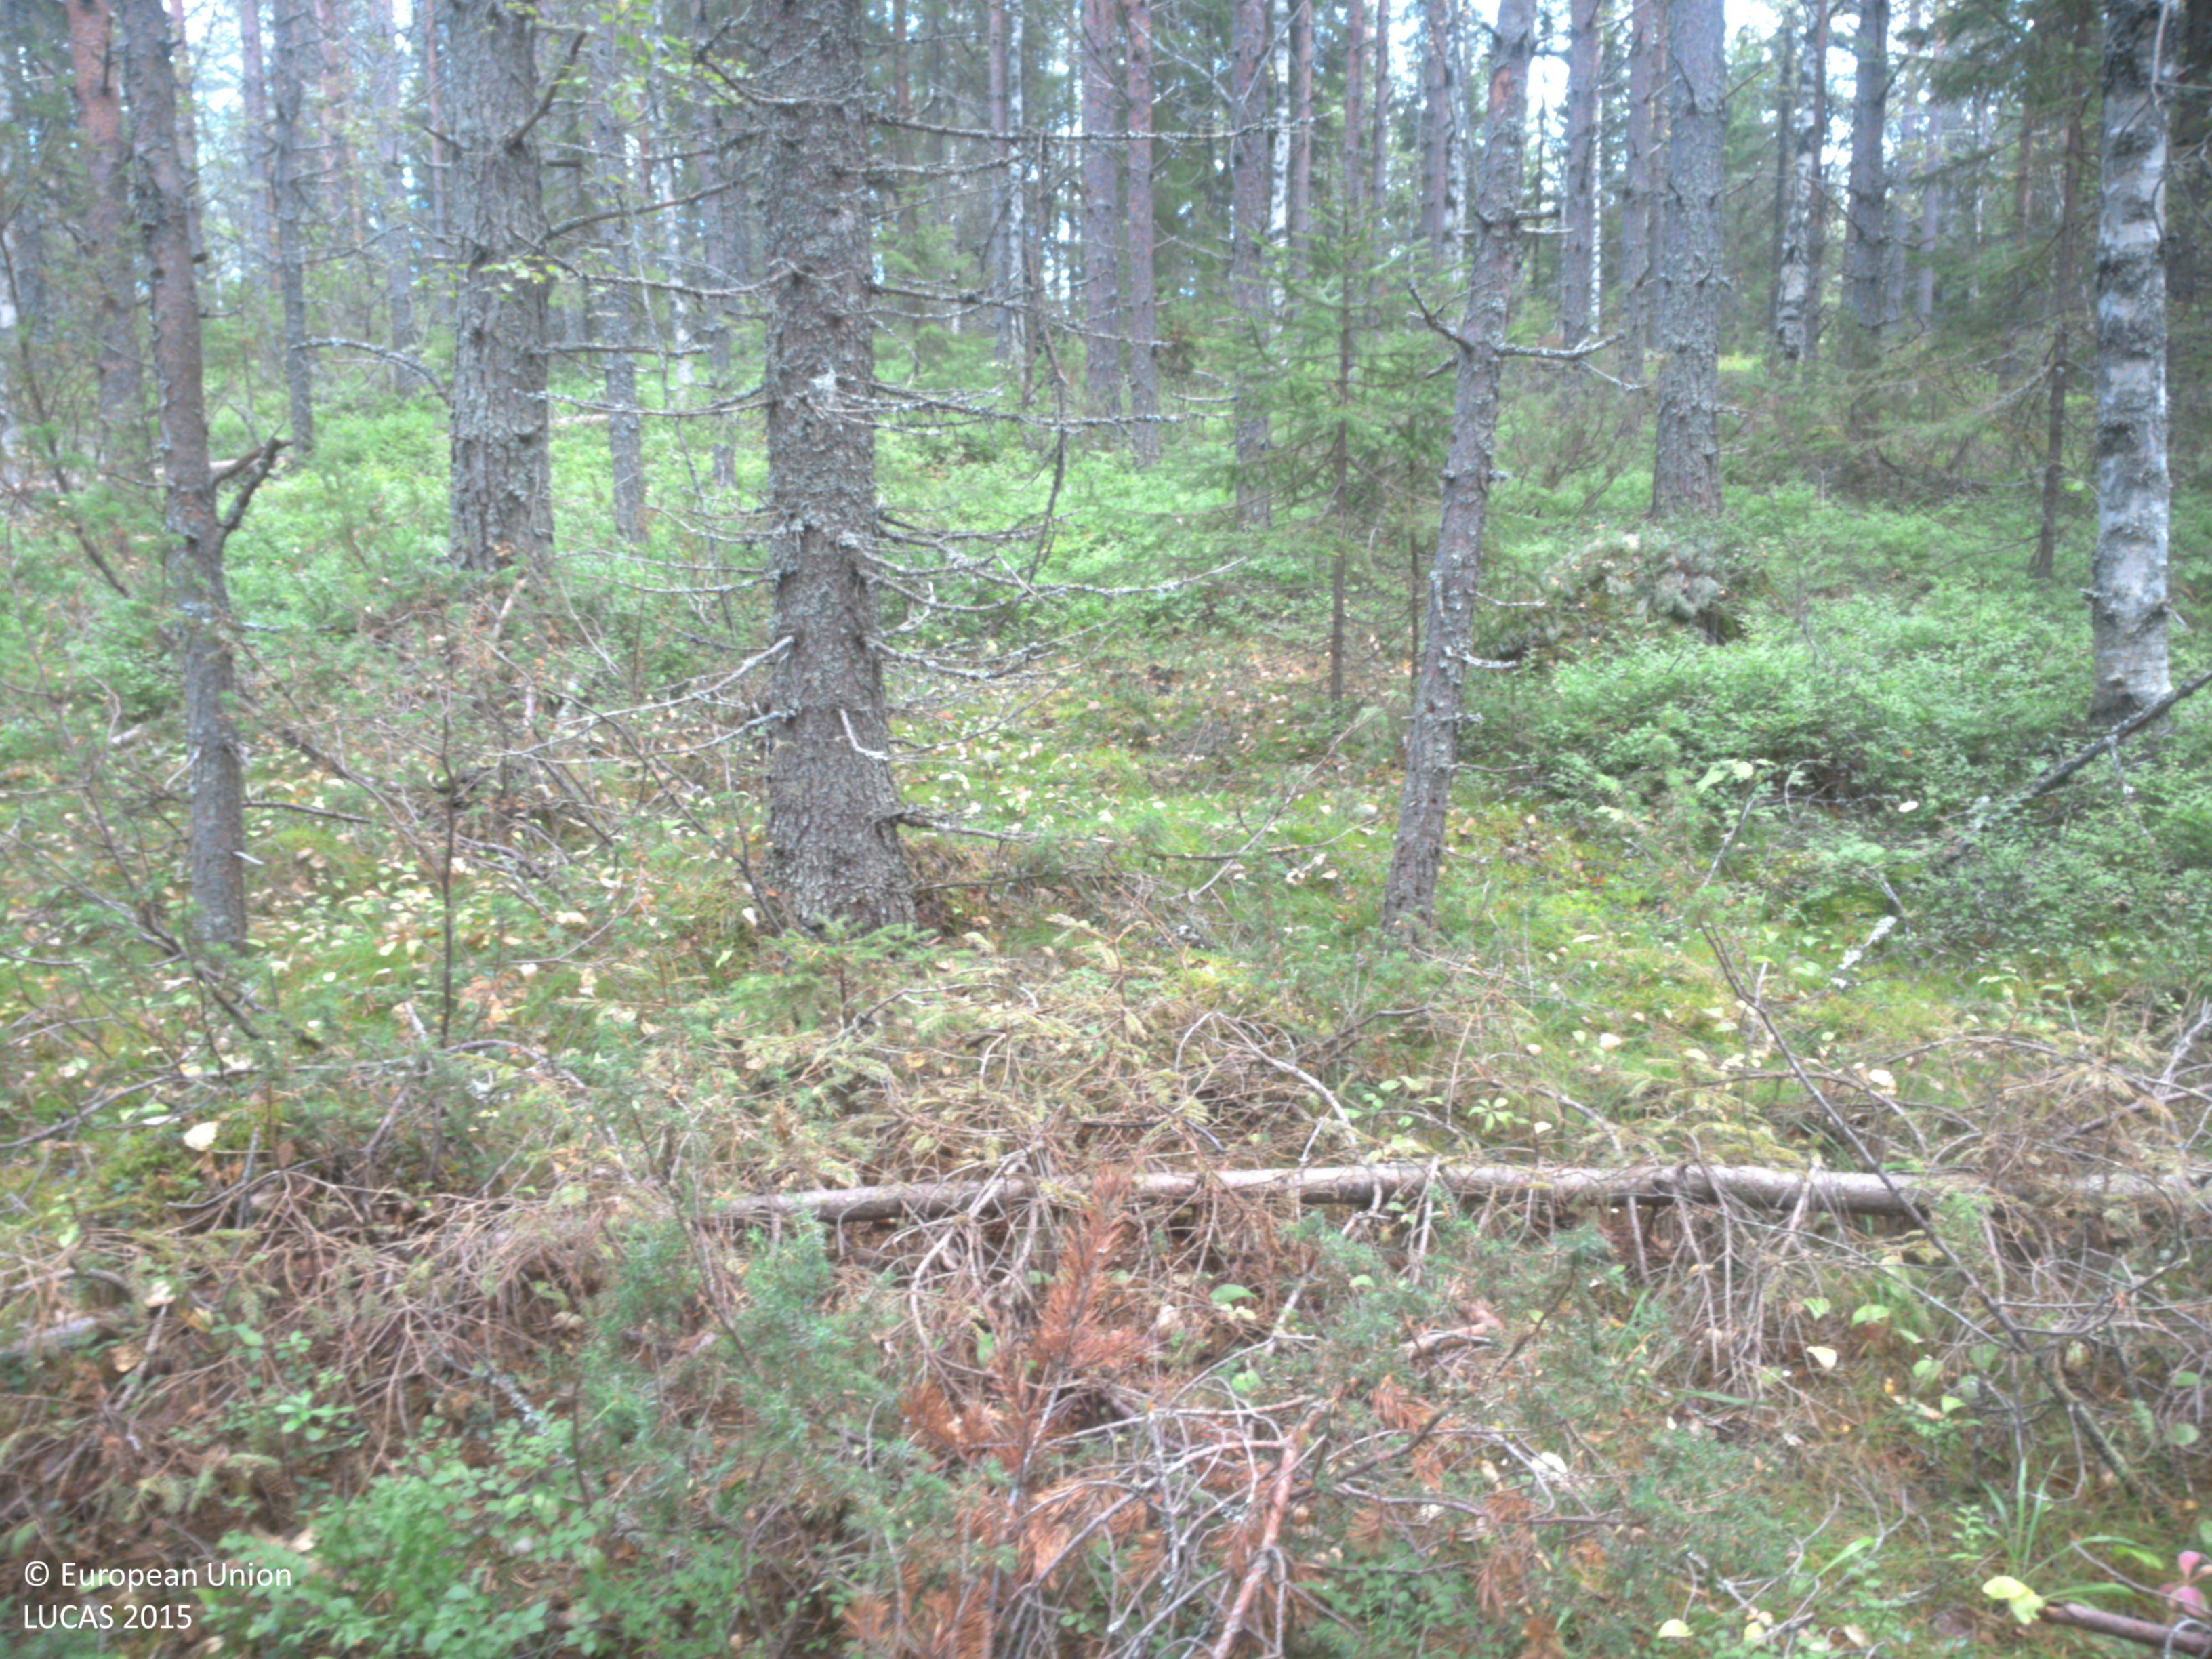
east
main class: Woodland
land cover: Pine dominated mixed woodland
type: boreal forest
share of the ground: 50 - 75 %
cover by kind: shrubs 45 %, coniferous forest trees 40 %, broadleaved forest trees 15 %
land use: Forestry
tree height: > 5 m
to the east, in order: Pine dominated mixed woodland; Other mixed woodland; Pine dominated mixed woodland; Spruce dominated mixed woodland; Tracks; Other mixed woodland; Pine dominated coniferous woodland; Lichens and moss
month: August
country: SE
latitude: 63.8473
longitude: 19.9642
